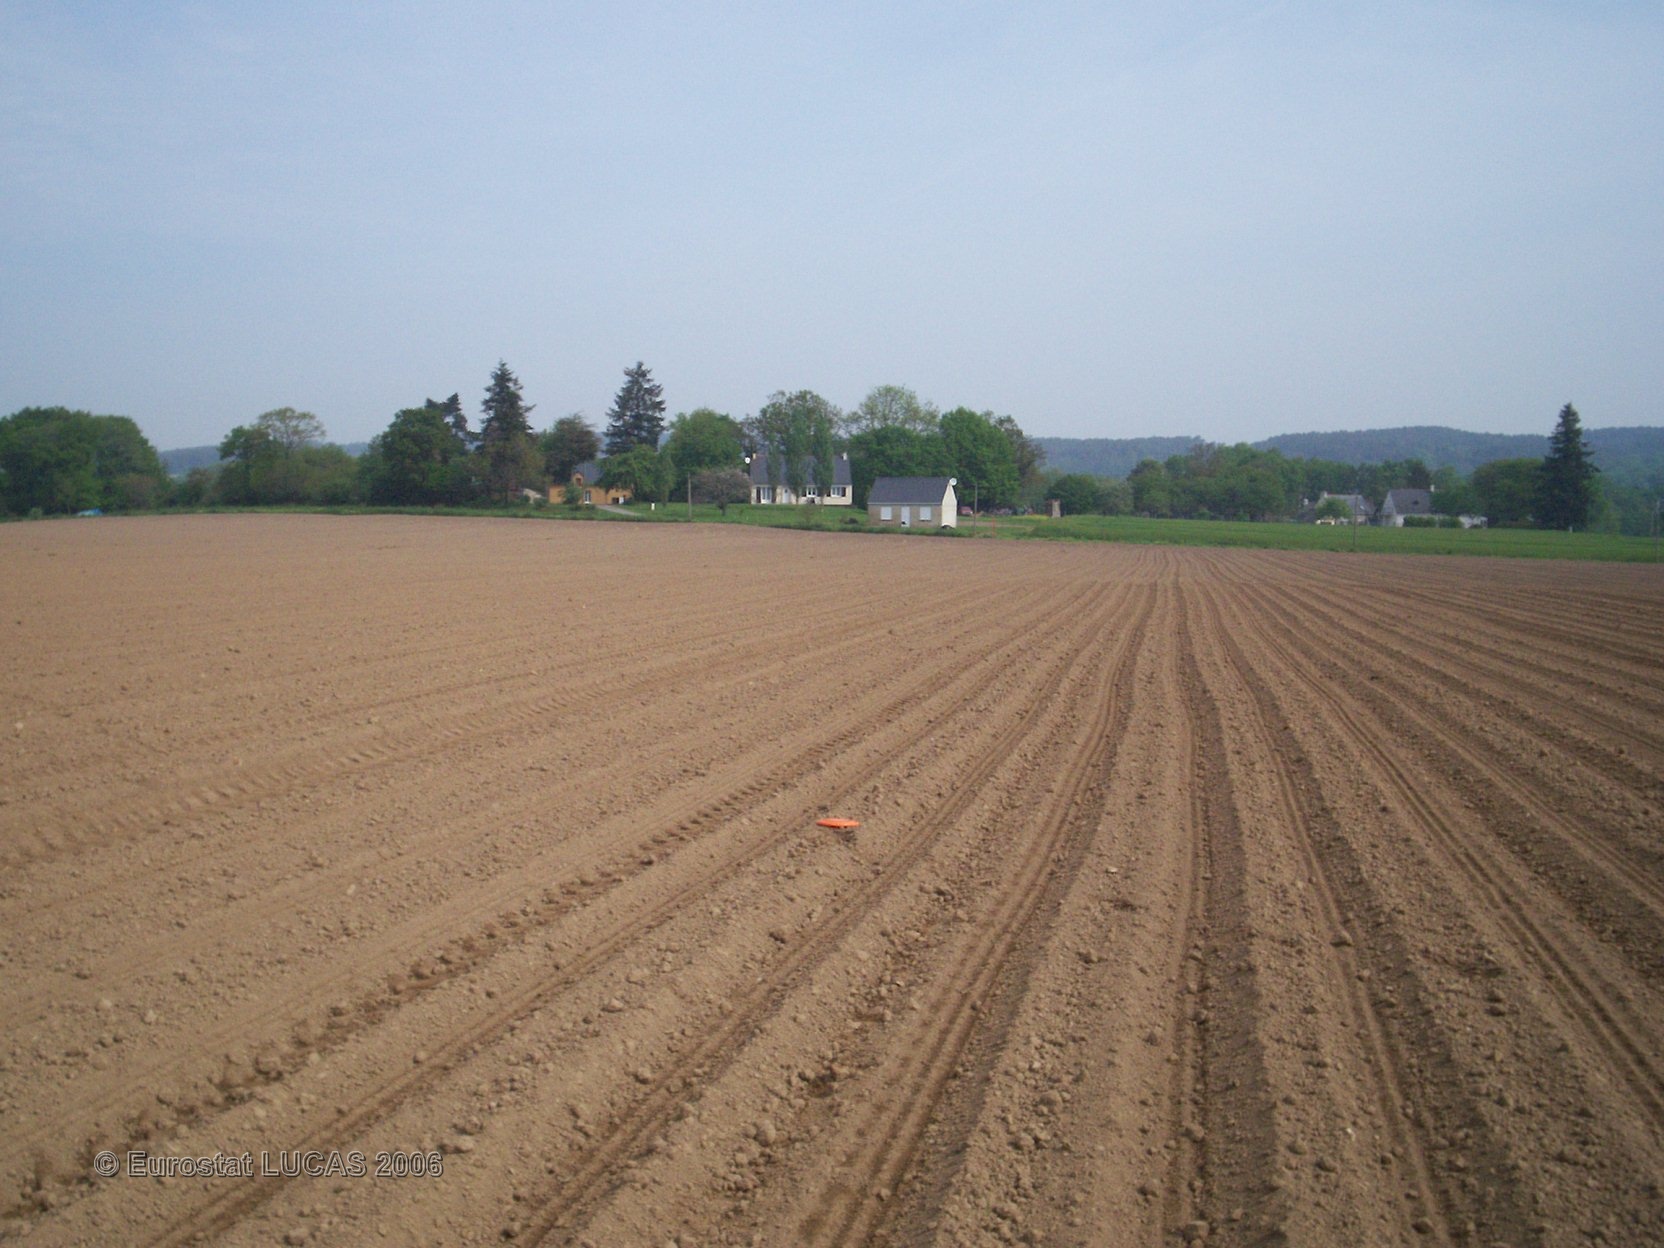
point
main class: Cropland
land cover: Maize
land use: Agriculture (excluding fallow land and kitchen gardens)
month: May
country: FR
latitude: 47.7633
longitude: -2.3438
